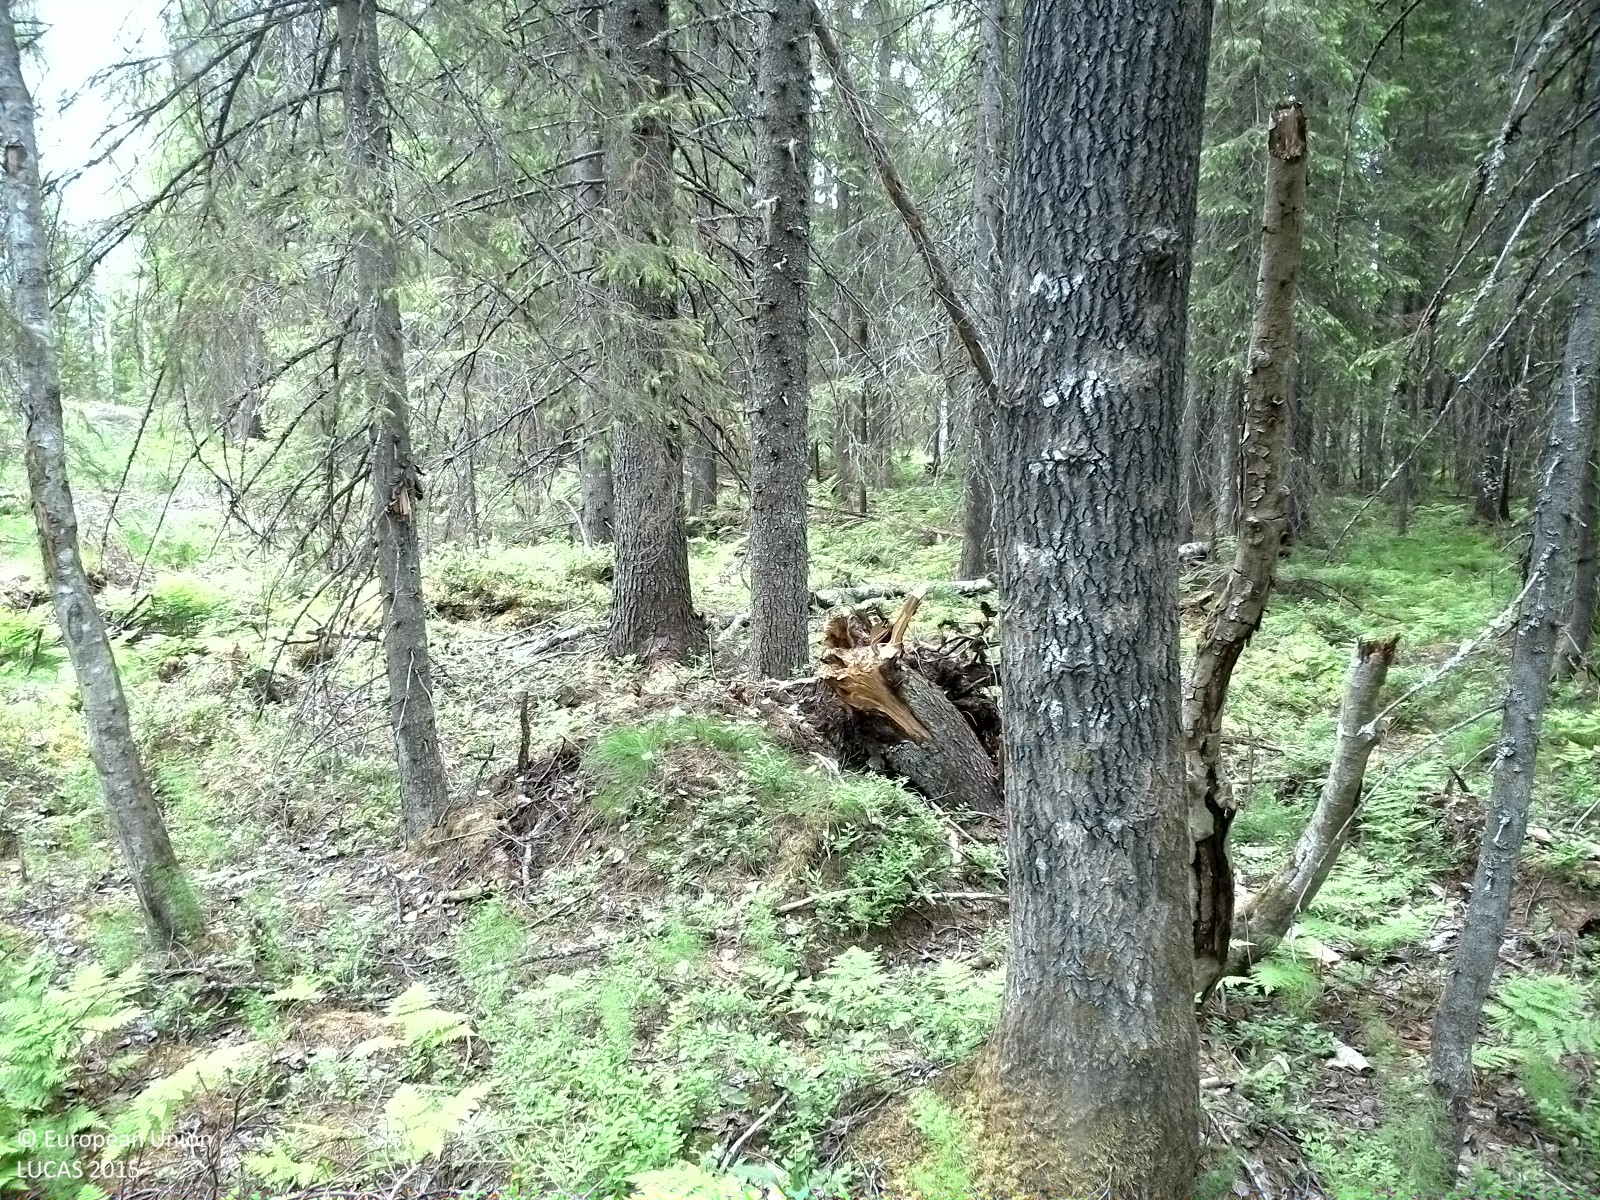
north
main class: Woodland
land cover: Spruce dominated coniferous woodland
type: boreal forest
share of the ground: 50 - 75 %
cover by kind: coniferous forest trees 50 %, shrubs 20 %, broadleaved forest trees 10 %, herbaceous plants 10 %, lichens and mosses 10 %
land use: Forestry
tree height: > 5 m
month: July
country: SE
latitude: 62.2212
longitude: 16.8471
